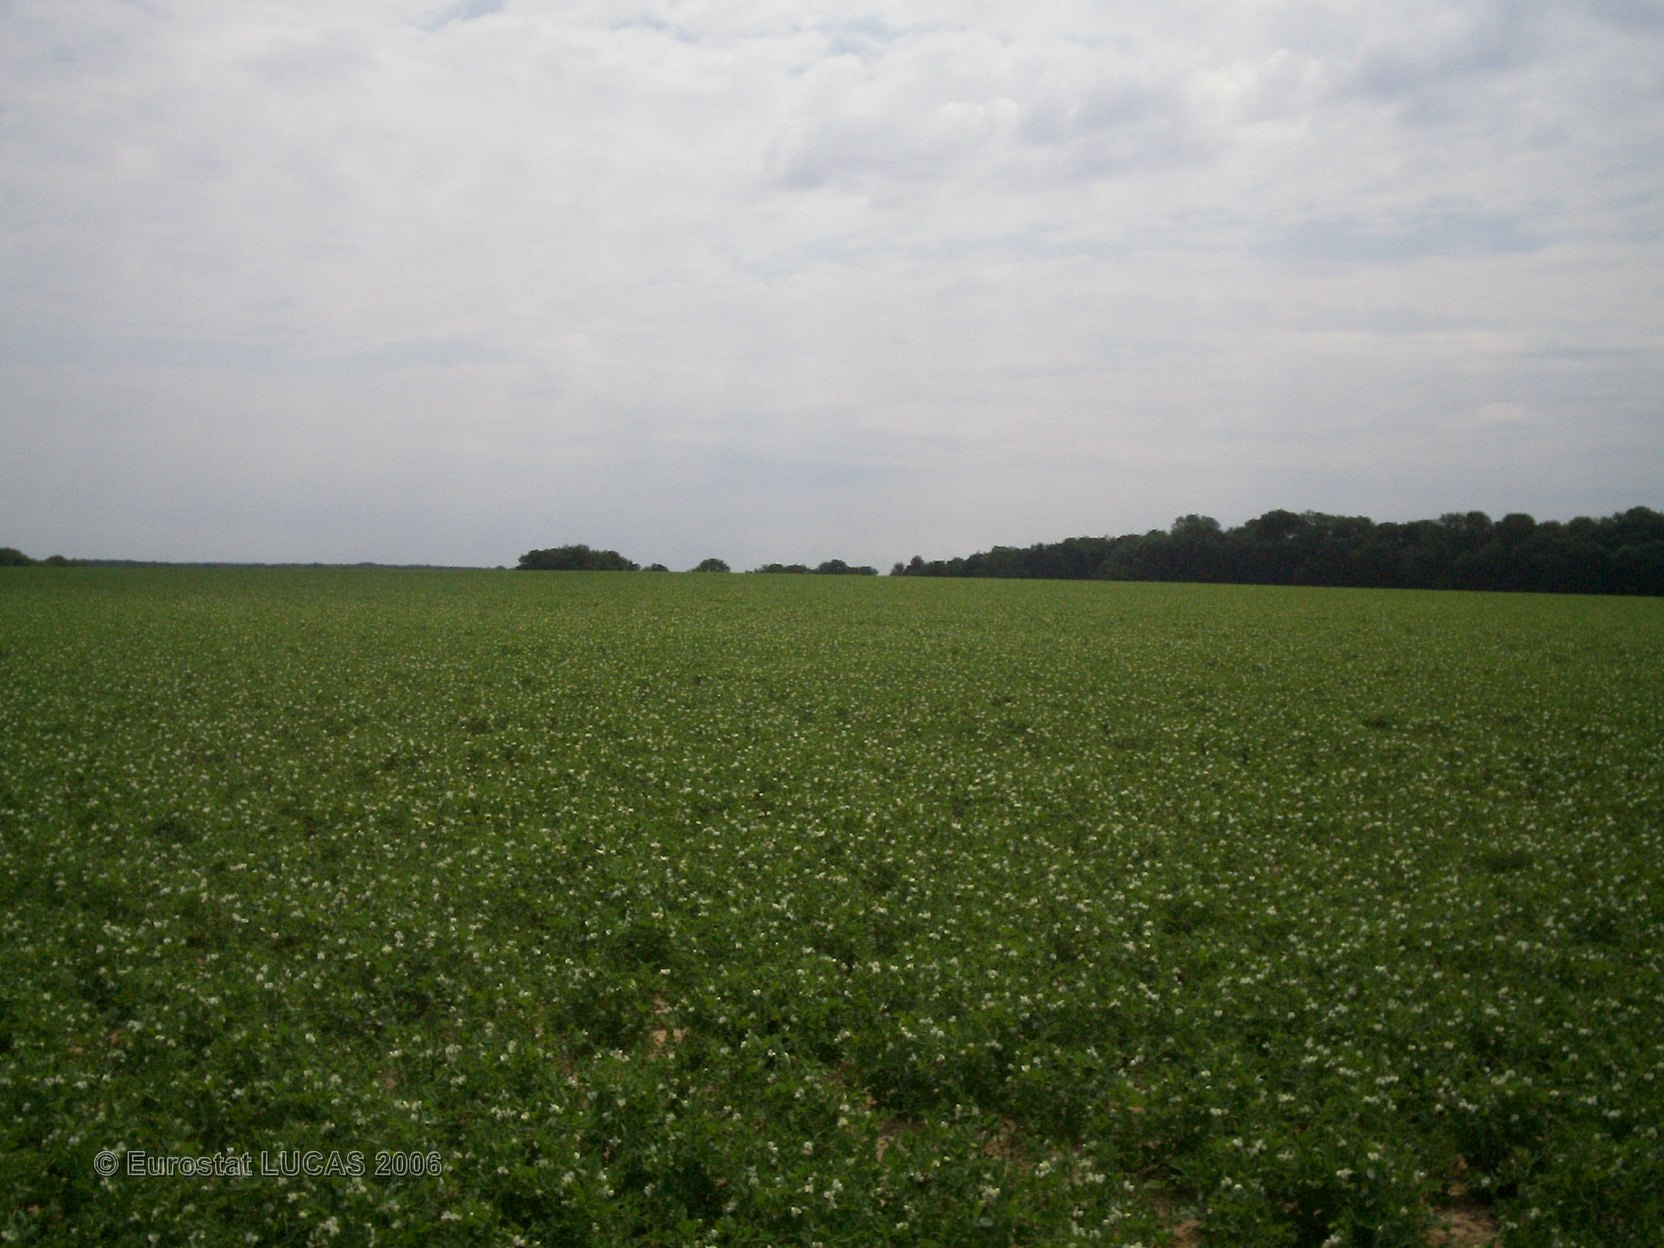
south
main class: Cropland
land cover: Dry pulses
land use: Agriculture (excluding fallow land and kitchen gardens)
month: June
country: FR
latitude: 49.7105
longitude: 2.6247
